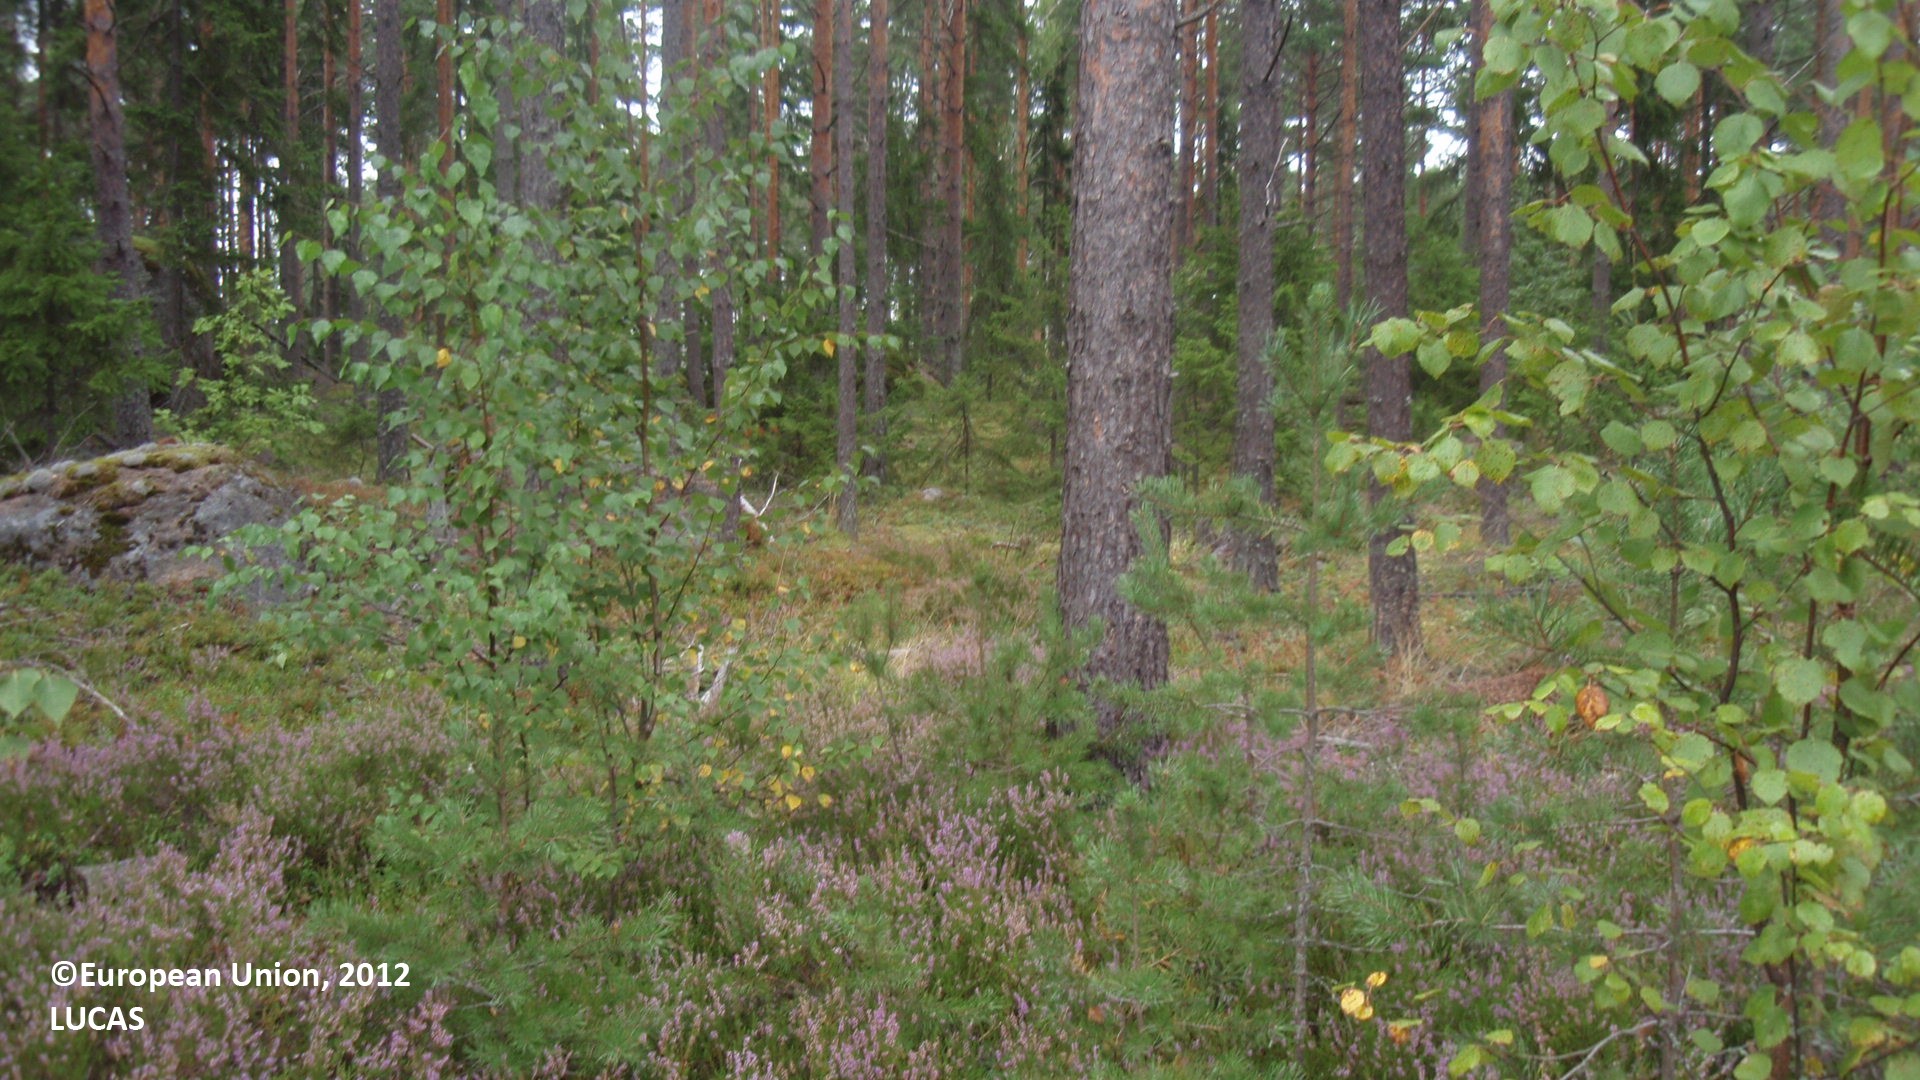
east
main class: Grassland
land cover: Grassland with sparse tree/shrub cover
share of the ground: > 75 %
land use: Abandoned areas
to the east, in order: Grassland with sparse tree/shrub cover; Fences; Grass margins; Pine dominated mixed woodland; Shrubland with sparse tree cover; Ditches and canals; Paved roads, cycling and walking lanes; Ditches and canals; Shrubland with sparse tree cover; Pine dominated coniferous woodland; Pine dominated mixed woodland; Artificial constructions in urban areas
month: August
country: FI
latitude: 60.5683
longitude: 27.0850
